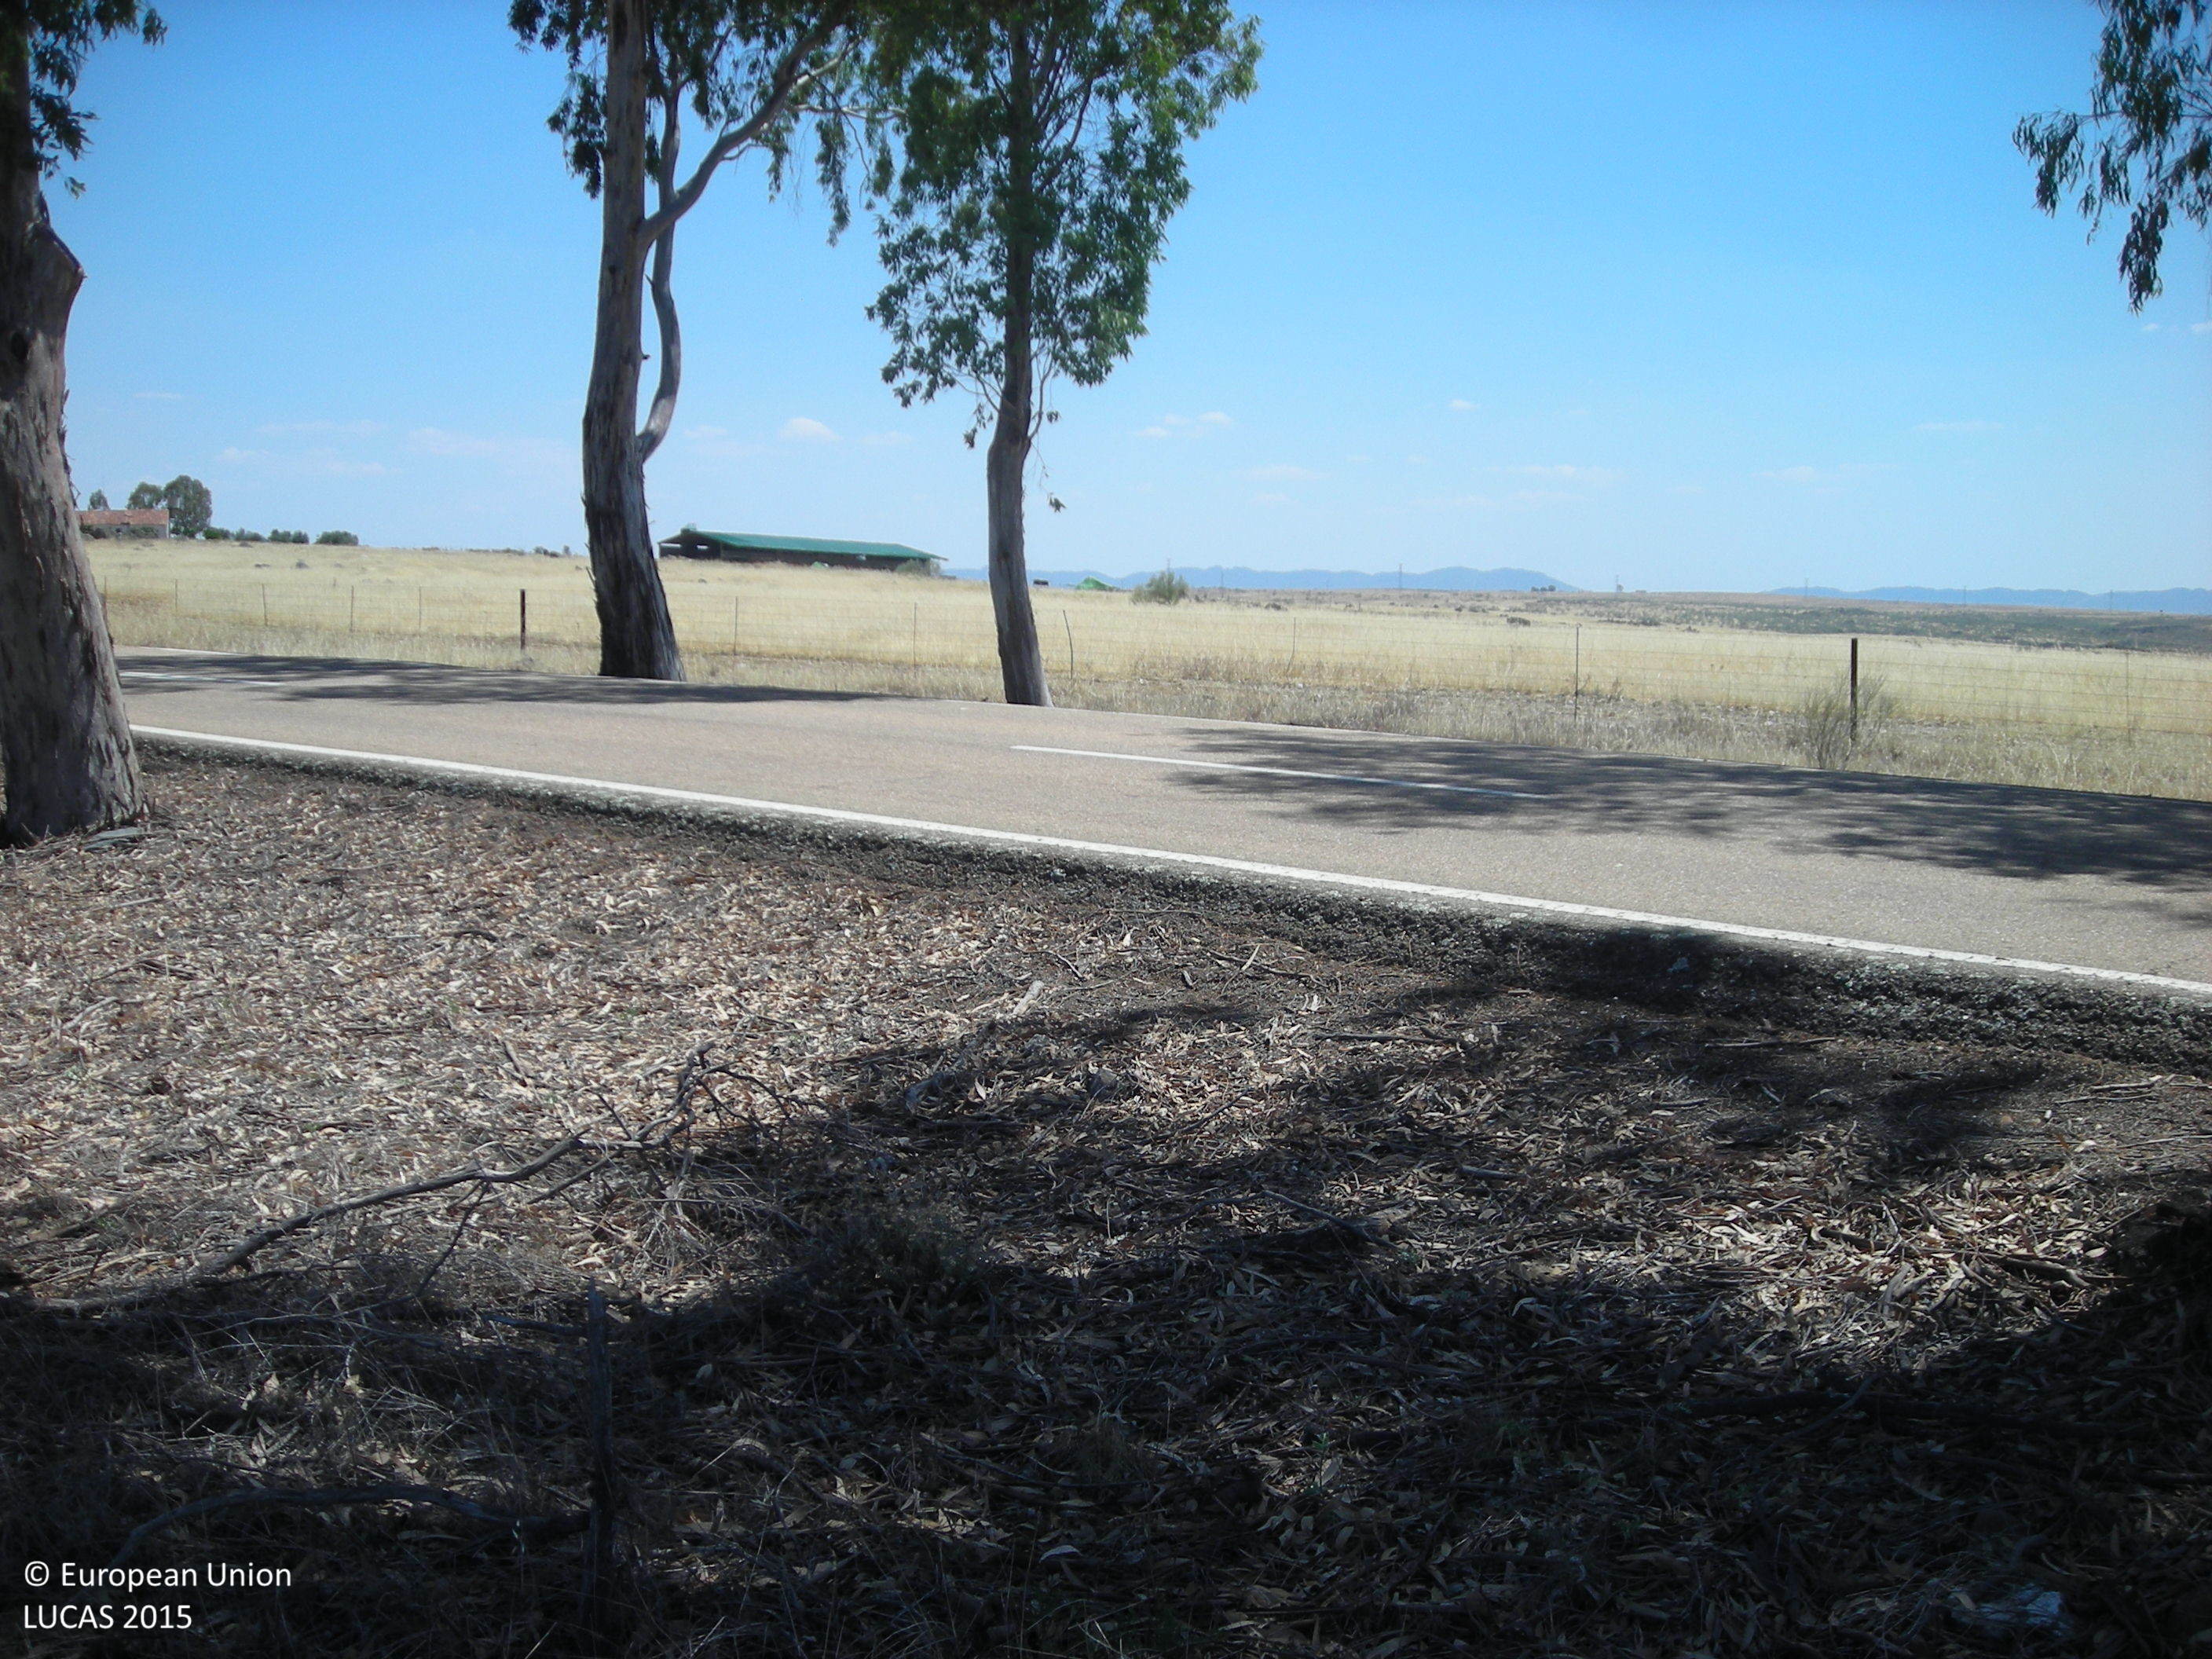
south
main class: Grassland
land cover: Grassland without tree/shrub cover
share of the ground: > 75 %
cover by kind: herbaceous plants 100 %
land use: Agriculture (excluding fallow land and kitchen gardens)
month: June
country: ES
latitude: 38.9050
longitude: -5.4588
